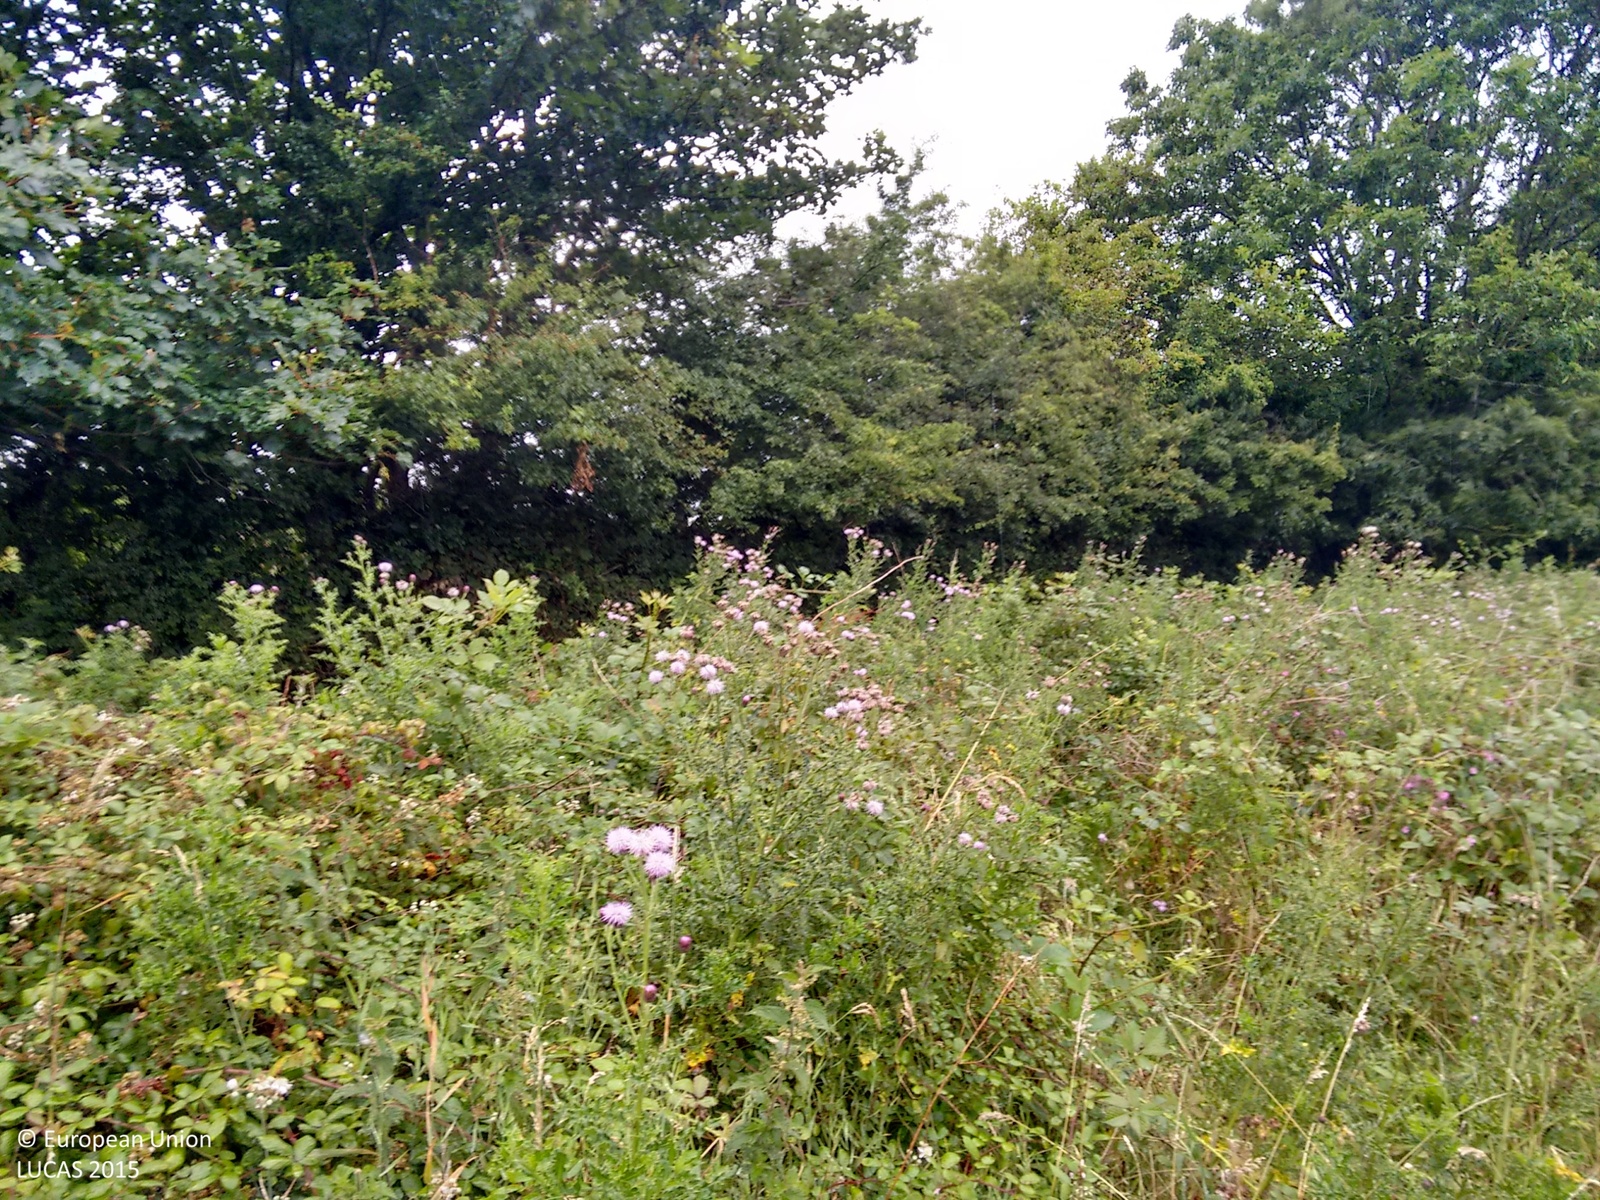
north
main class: Shrubland
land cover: Shrubland with sparse tree cover
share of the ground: > 75 %
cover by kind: shrubs 95 %, broadleaved forest trees 5 %
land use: Agriculture (excluding fallow land and kitchen gardens)
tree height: < 5 m
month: August
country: GB
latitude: 53.1373
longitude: -4.2555
